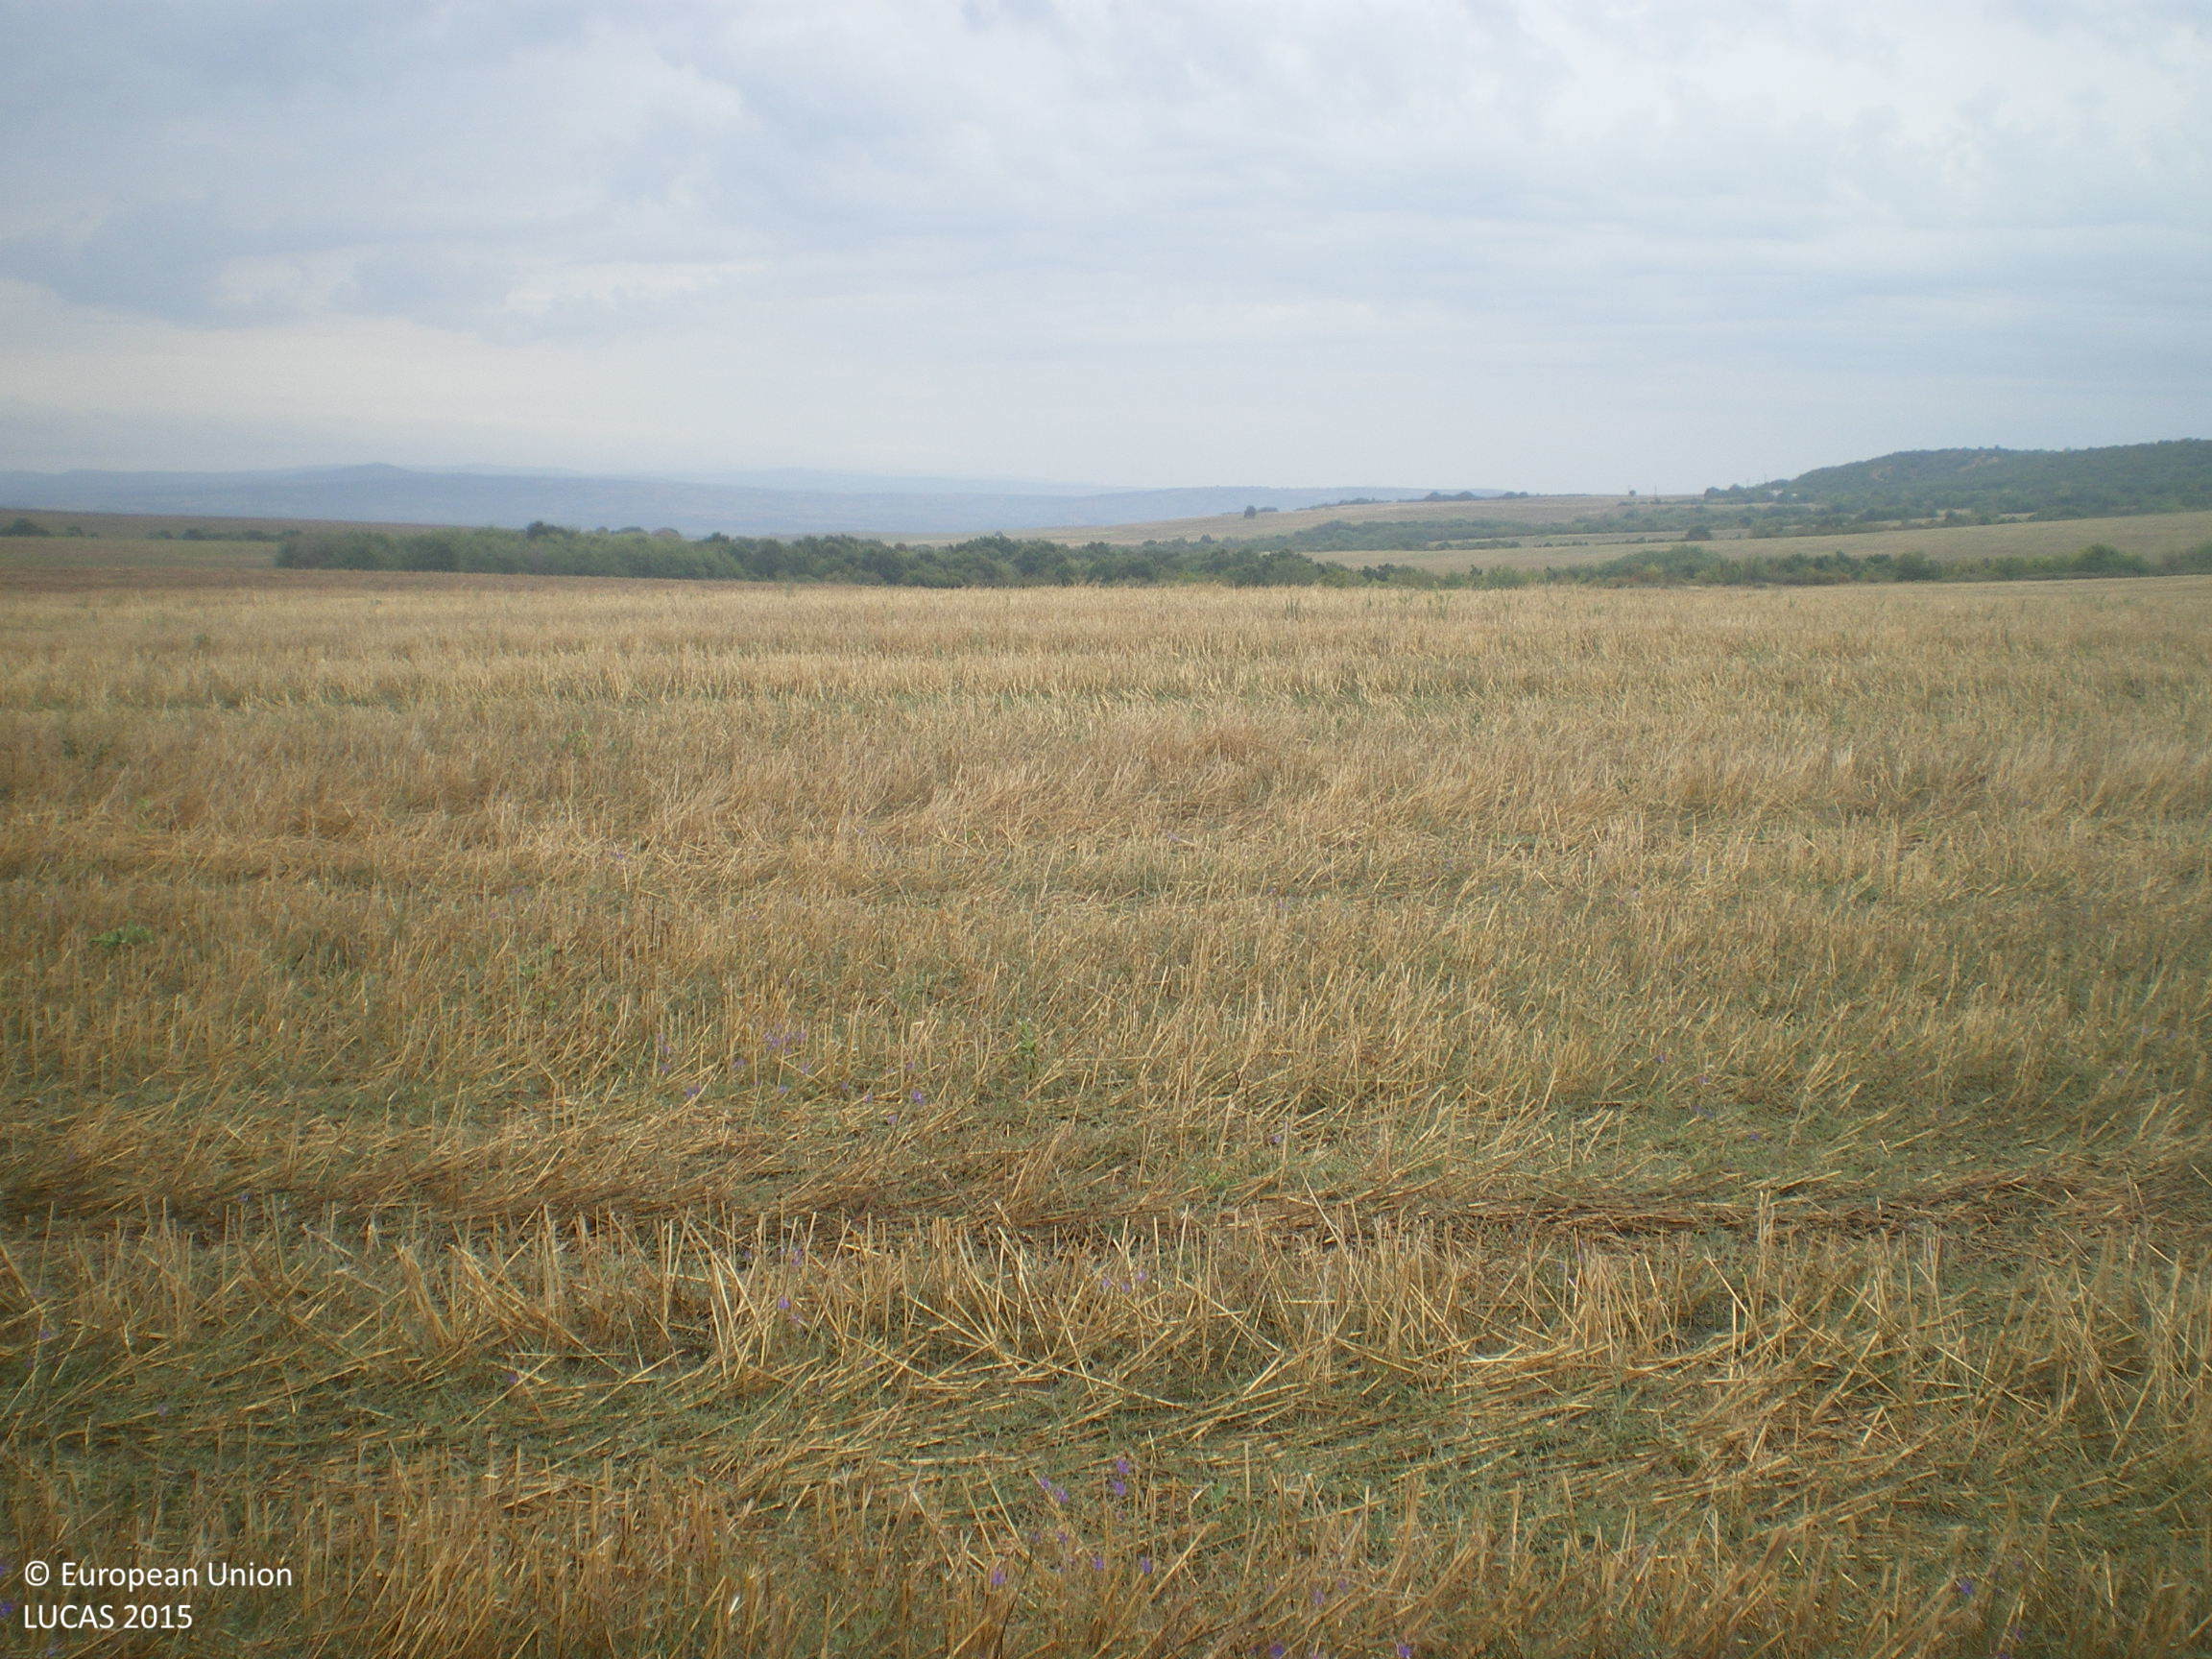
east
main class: Cropland
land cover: Common wheat
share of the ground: 25 - 50 %
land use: Agriculture (excluding fallow land and kitchen gardens)
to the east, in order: Common wheat; Grass margins; Tracks; Grass margins; Sunflower
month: September
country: BG
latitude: 41.9499
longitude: 25.8371
